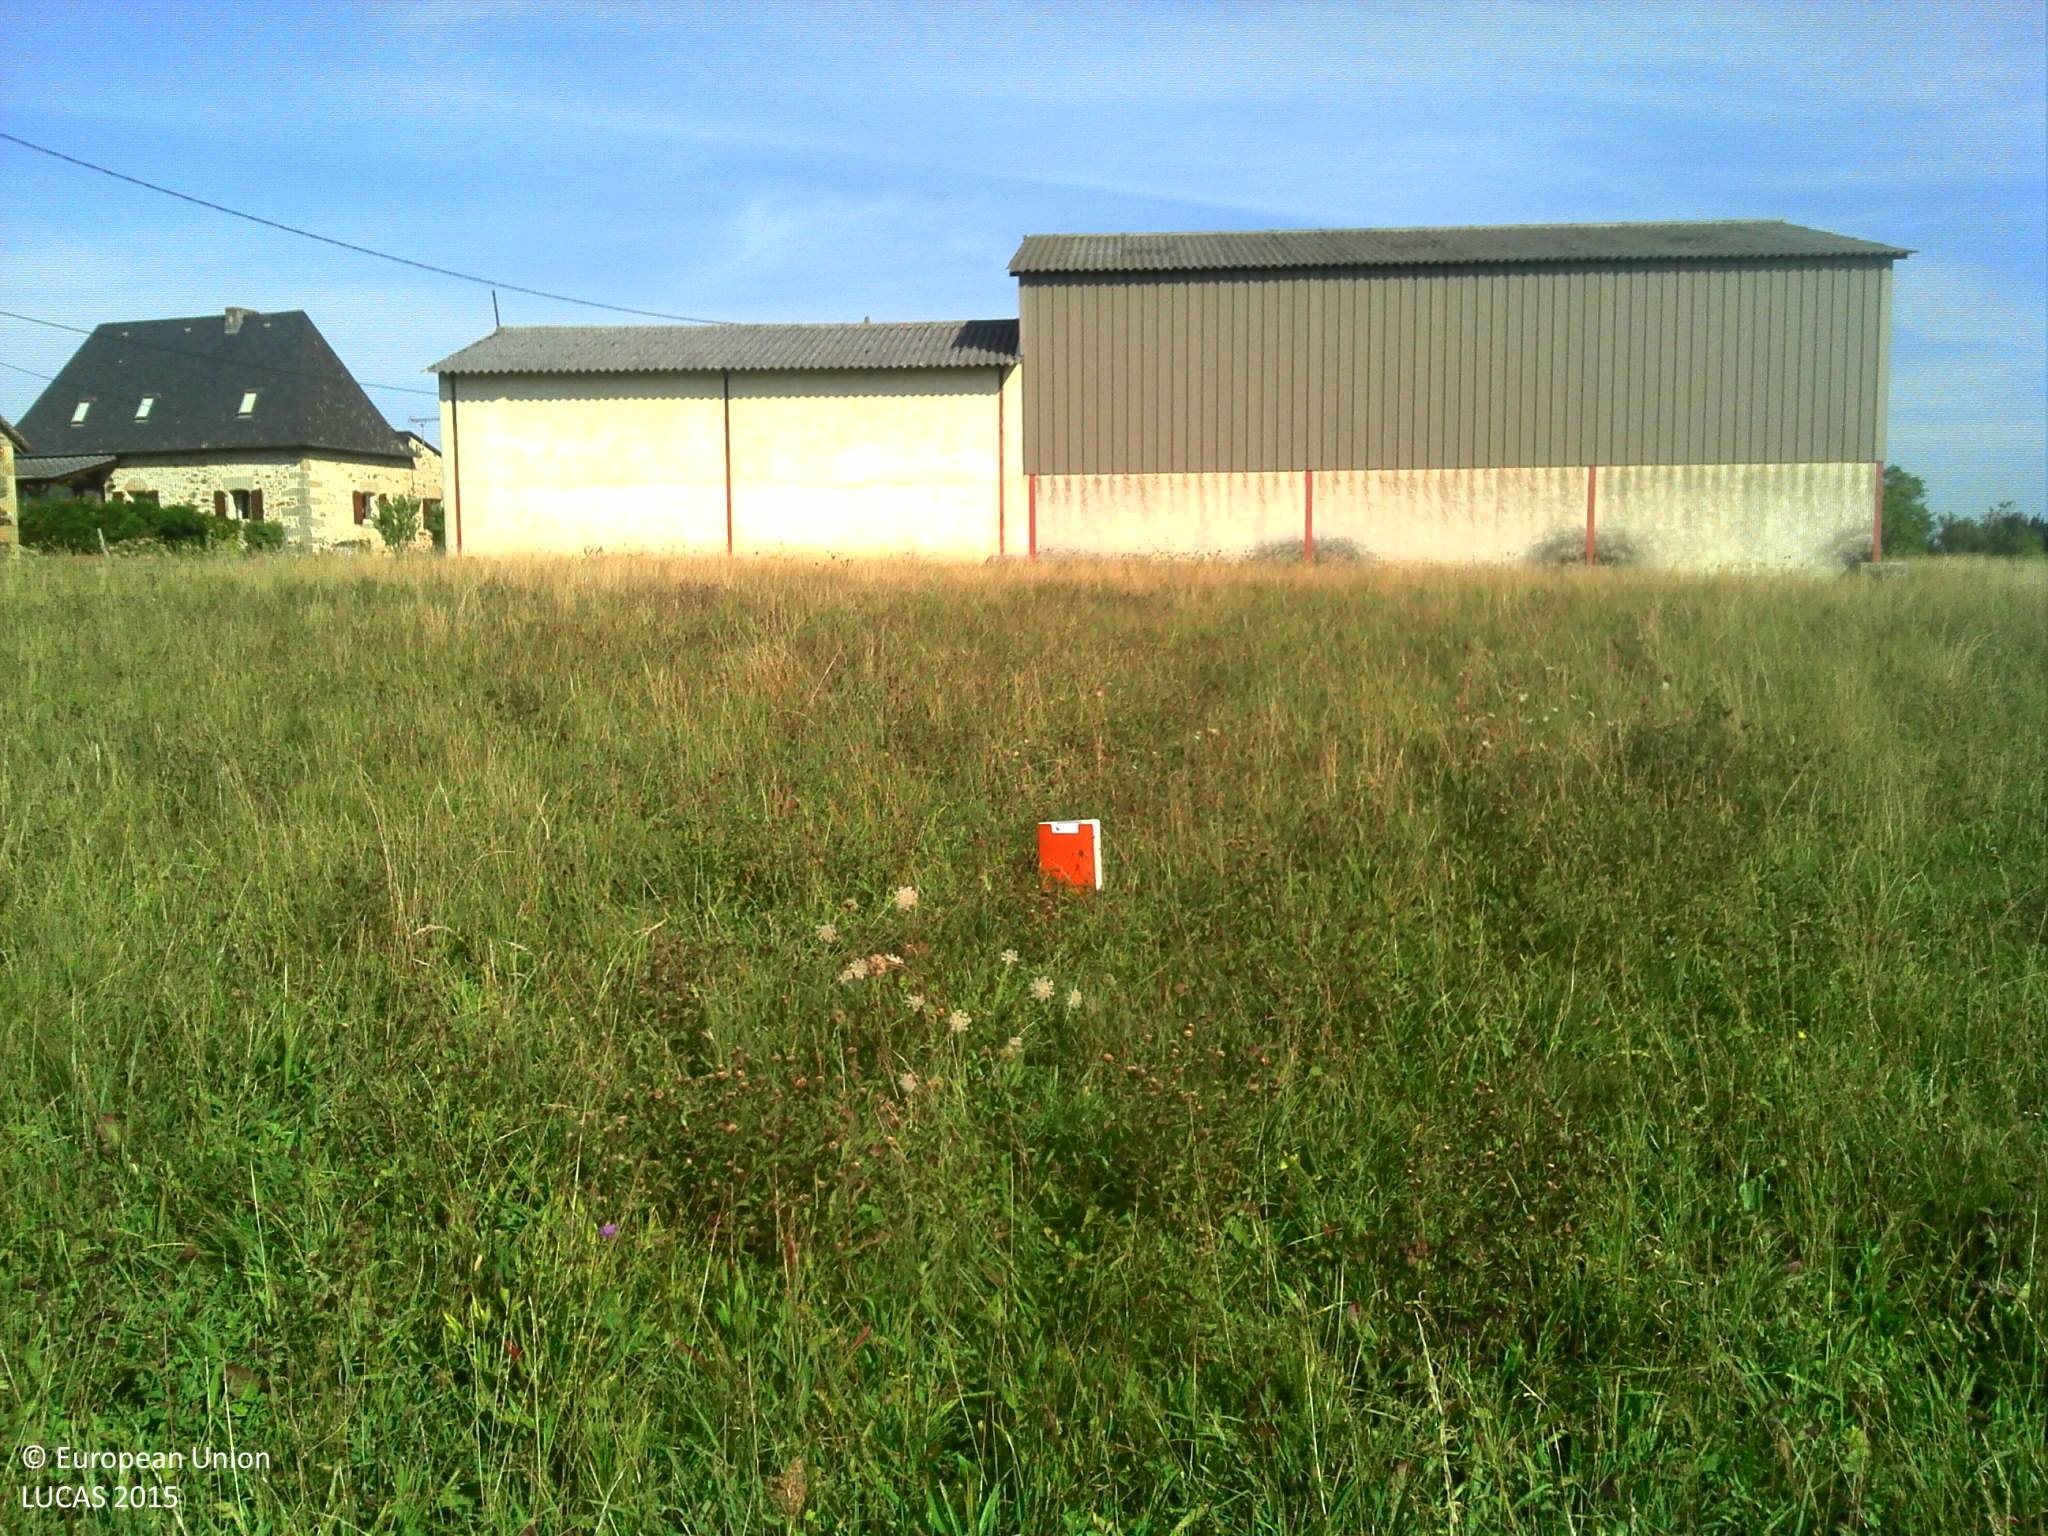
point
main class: Grassland
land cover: Grassland without tree/shrub cover
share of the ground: > 75 %
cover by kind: herbaceous plants 100 %
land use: Agriculture (excluding fallow land and kitchen gardens)
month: August
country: FR
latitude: 44.8178
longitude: 1.9689
